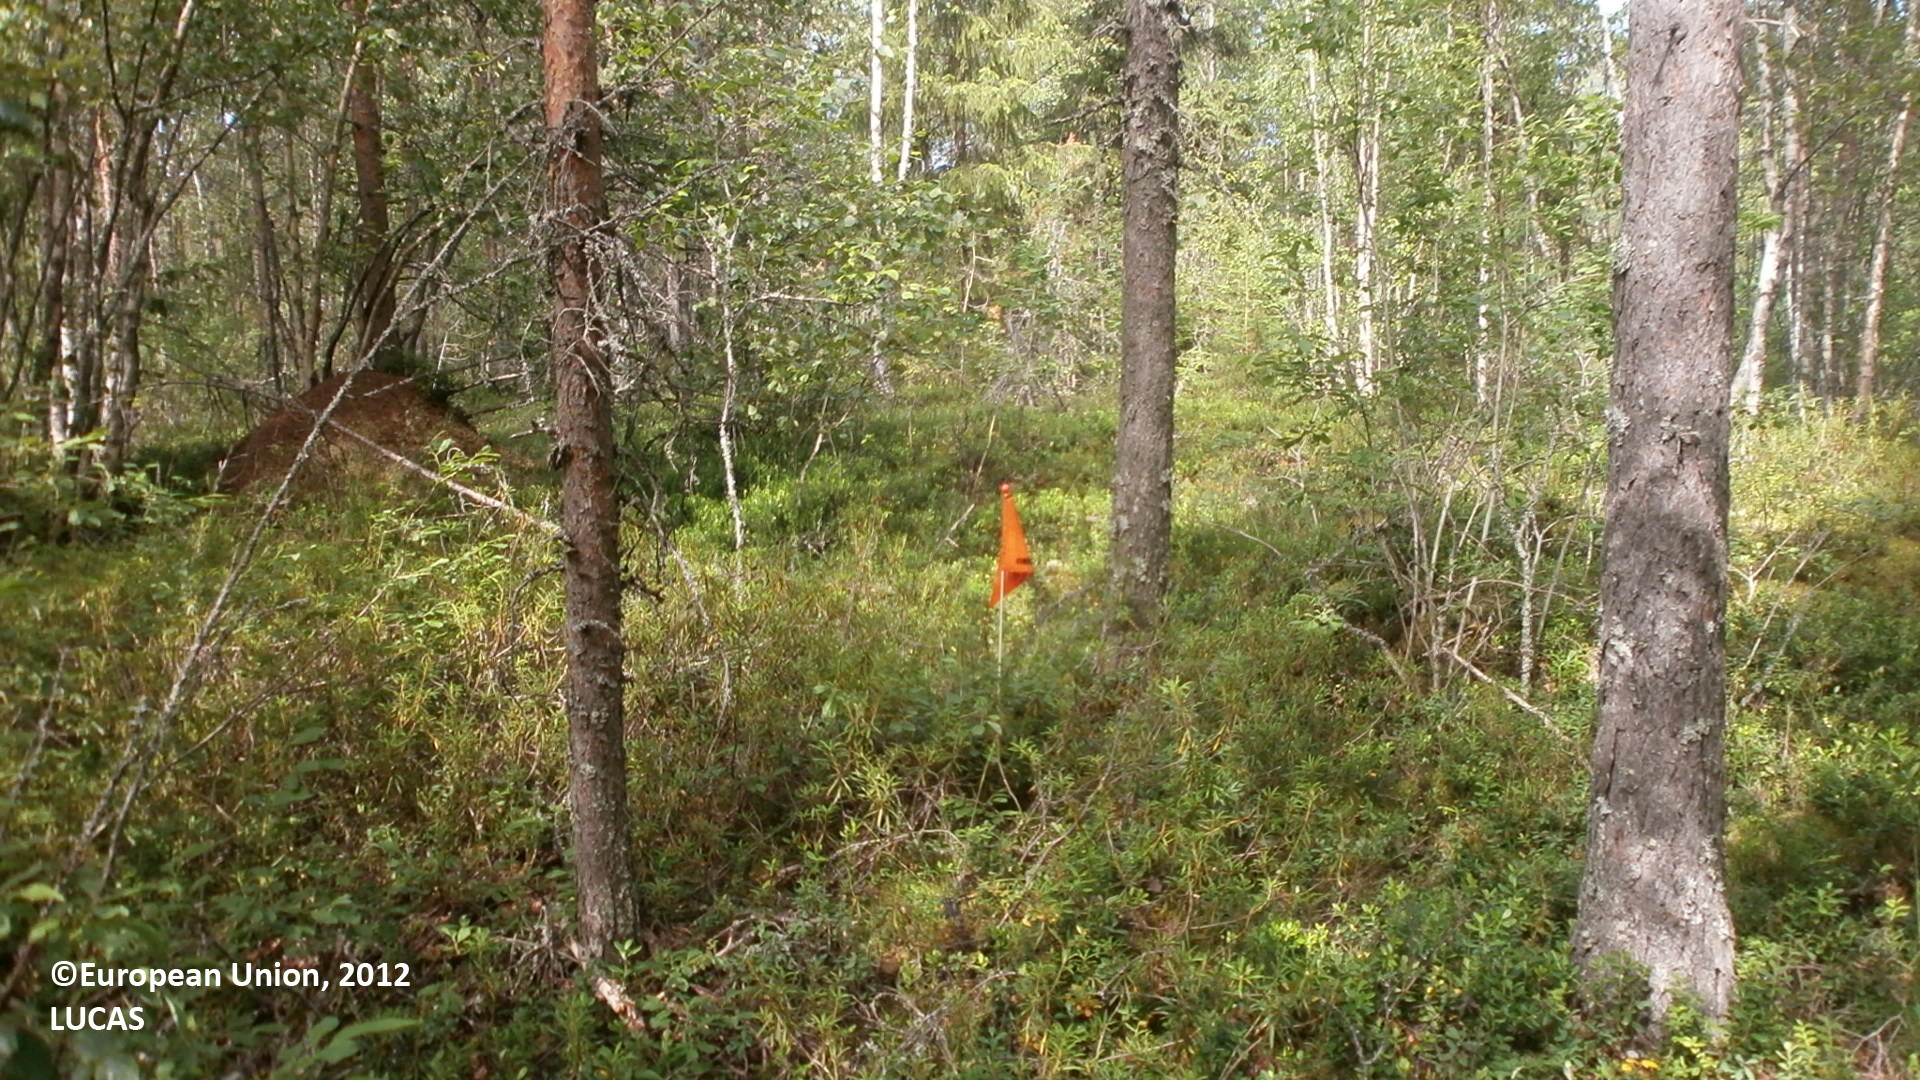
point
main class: Woodland
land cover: Pine dominated mixed woodland
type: boreal forest
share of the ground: 50 - 75 %
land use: Forestry
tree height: > 5 m
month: July
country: FI
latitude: 64.2349
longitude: 24.1904
